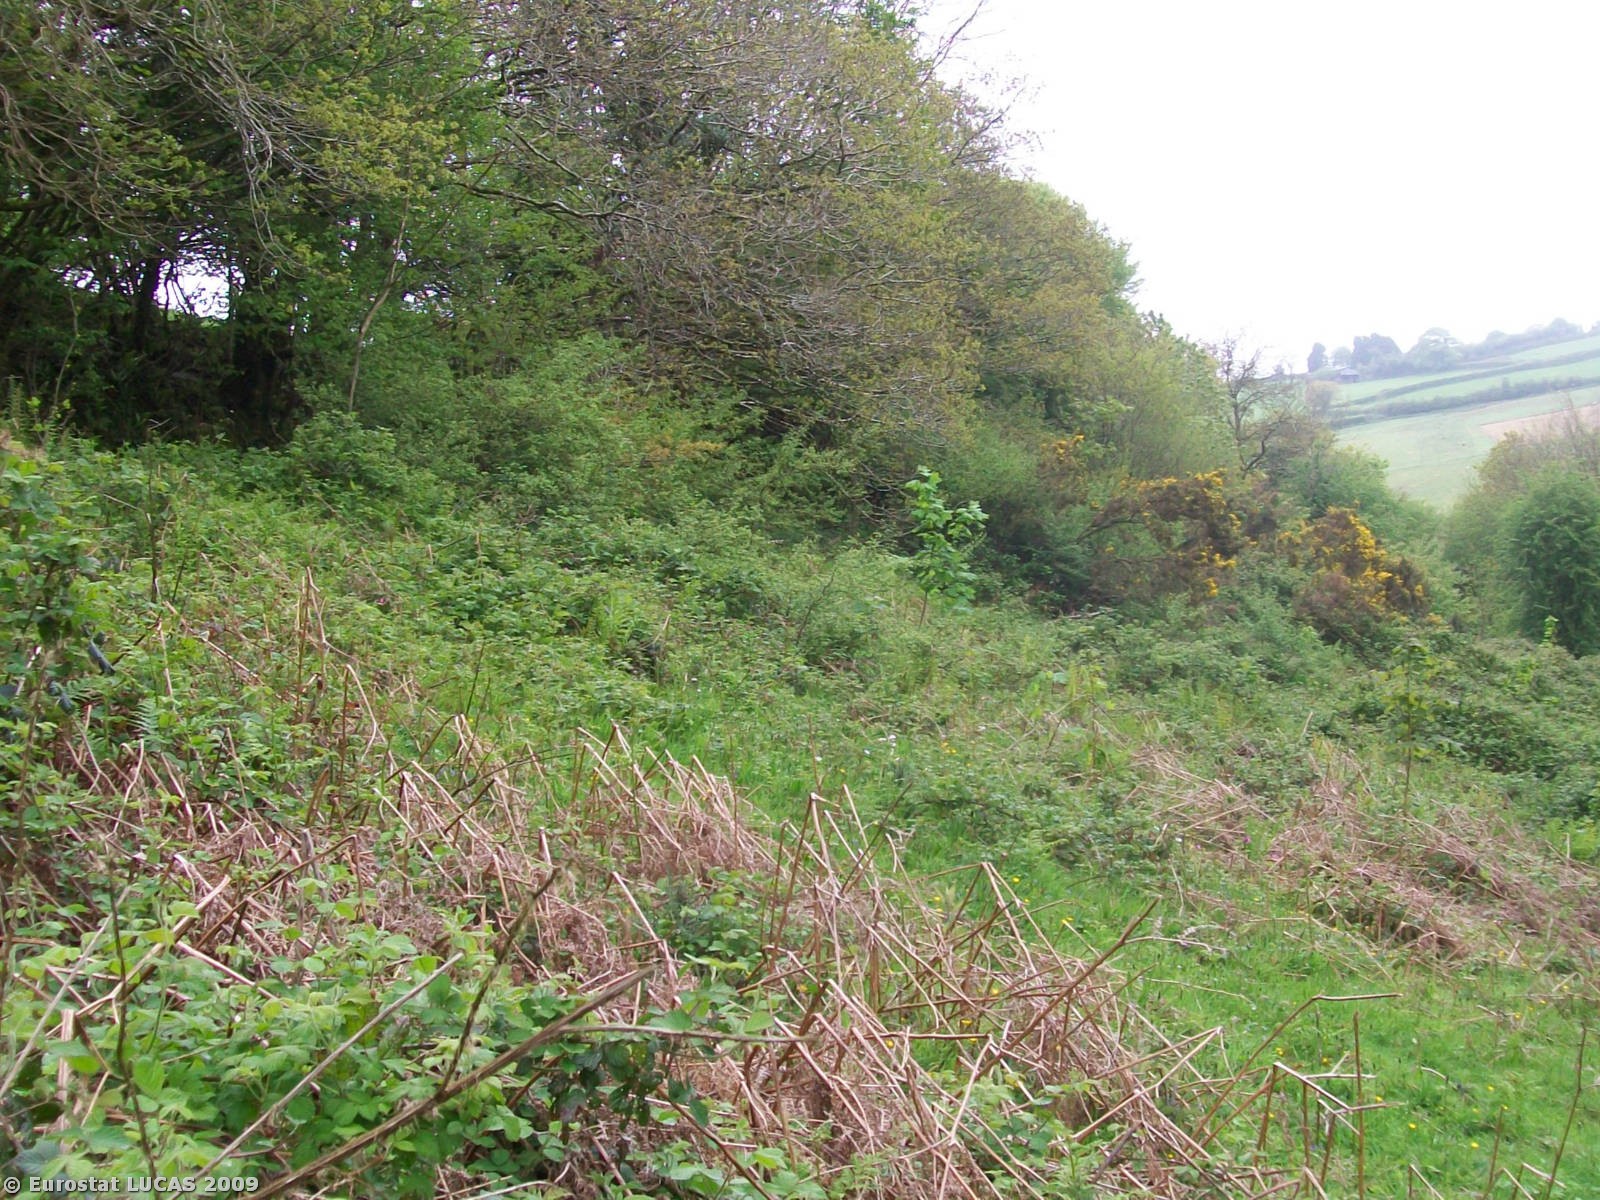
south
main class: Shrubland
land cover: Shrubland with sparse tree cover
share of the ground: > 75 %
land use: Agriculture (excluding fallow land and kitchen gardens)
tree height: > 5 m
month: May
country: GB
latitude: 50.5046
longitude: -4.2695
